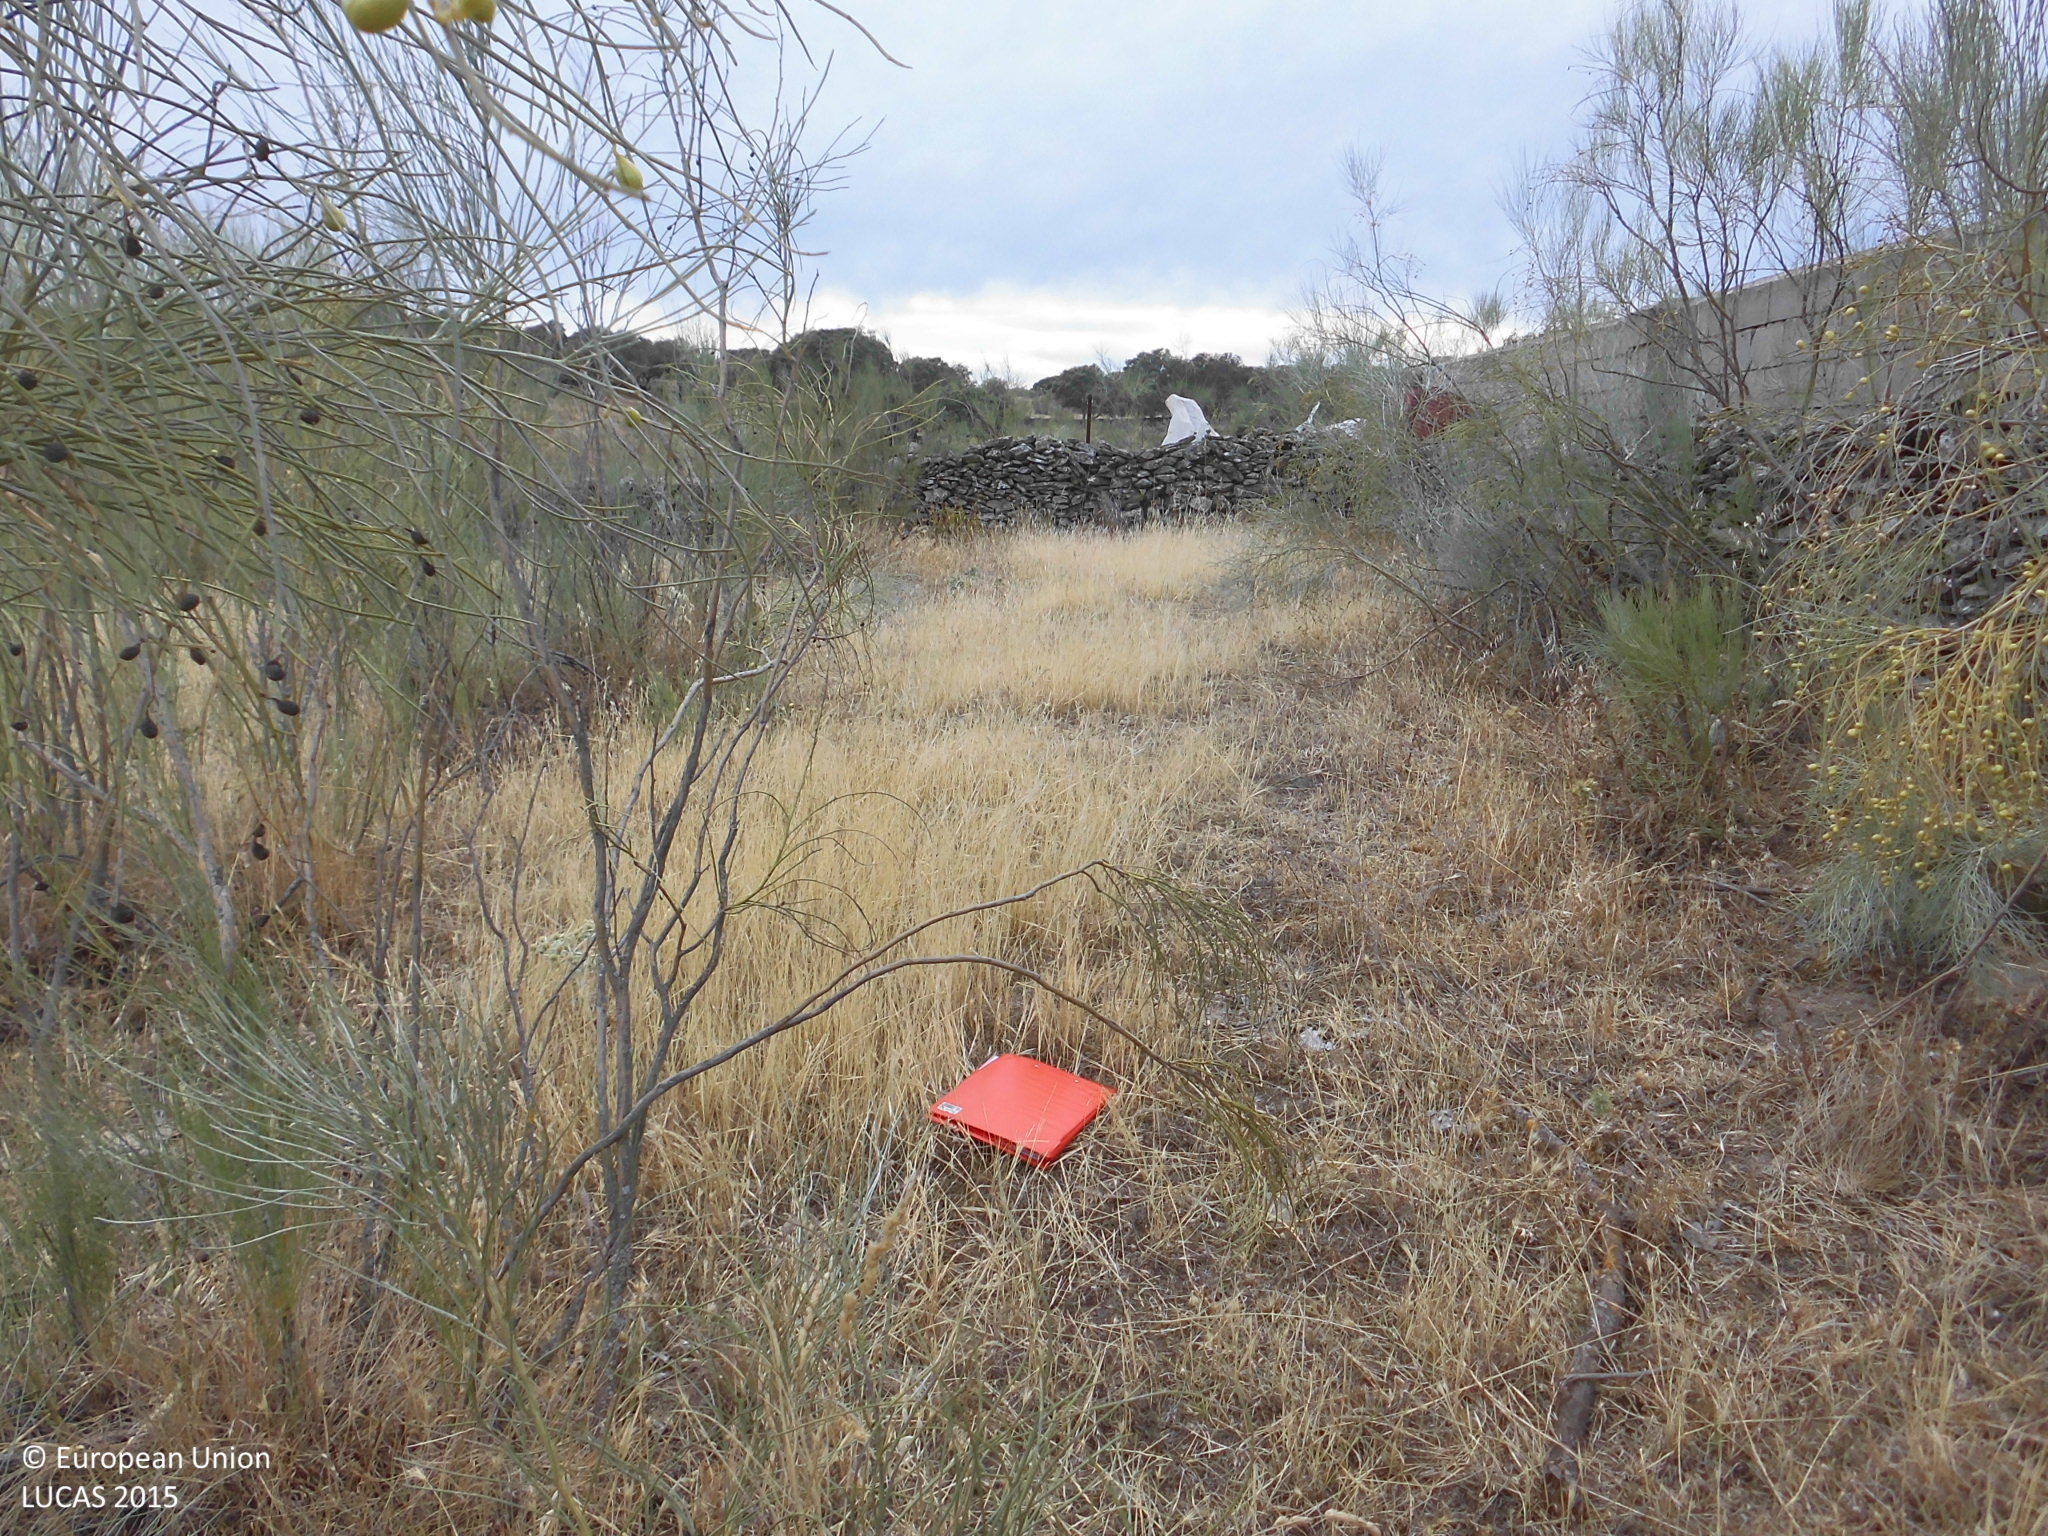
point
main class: Shrubland
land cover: Shrubland without tree cover
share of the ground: 10 - 25 %
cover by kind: herbaceous plants 75 %, shrubs 20 %, consolidated bare surface 5 %
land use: Agriculture (excluding fallow land and kitchen gardens)
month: July
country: ES
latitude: 39.8934
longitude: -6.4856
